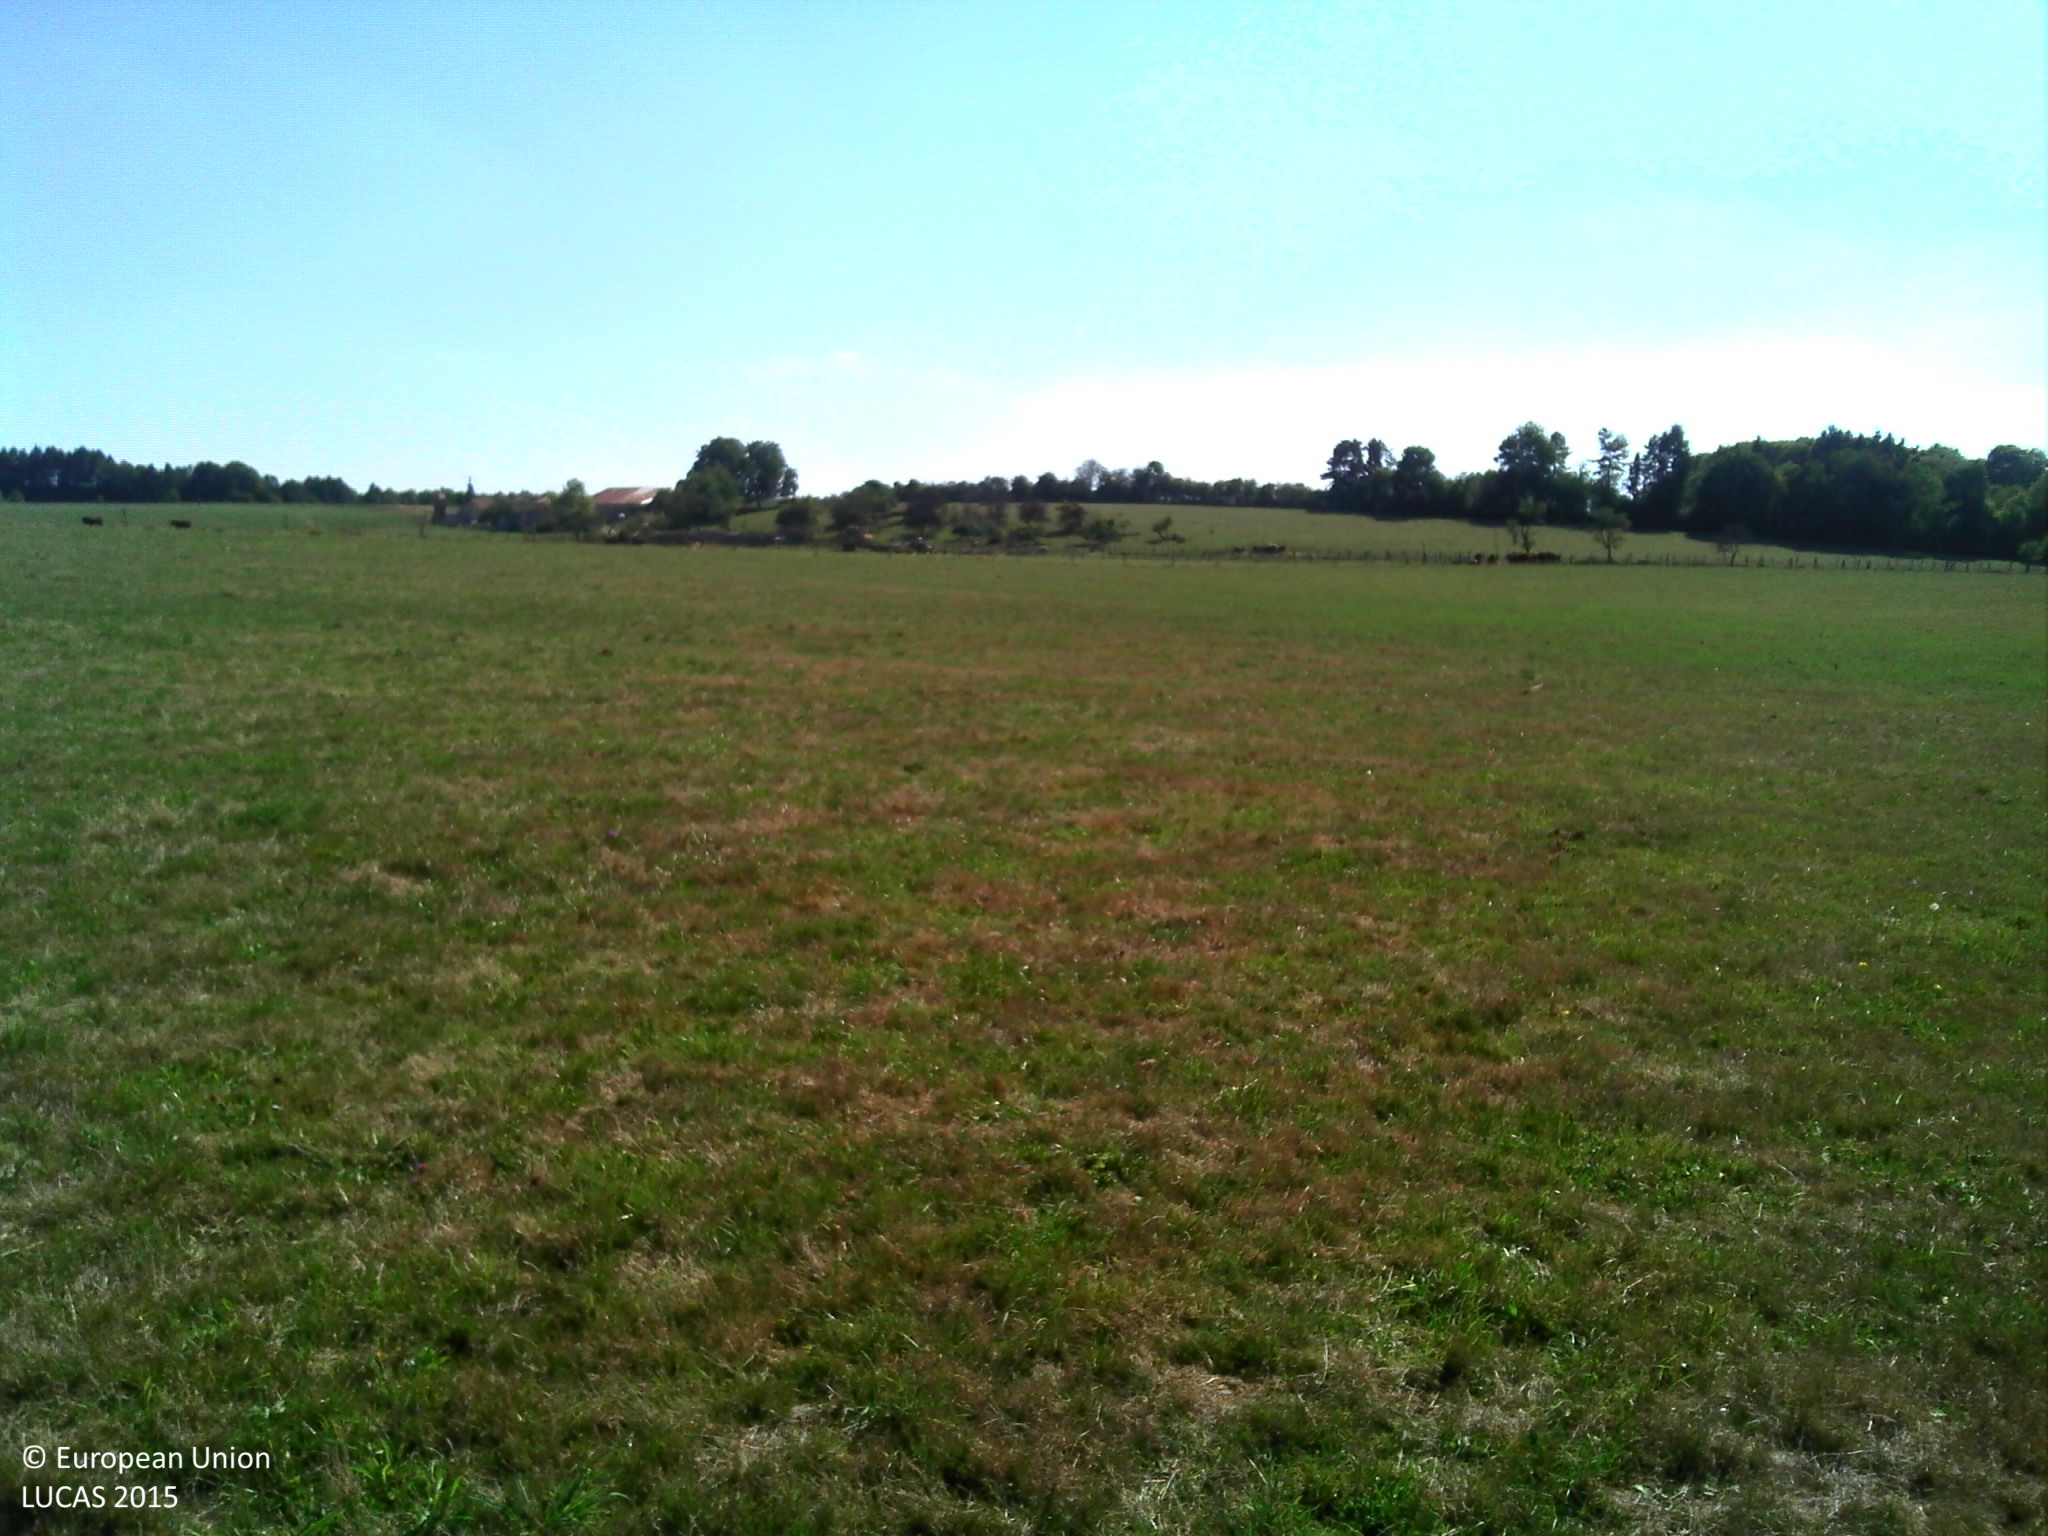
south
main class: Grassland
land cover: Grassland without tree/shrub cover
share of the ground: > 75 %
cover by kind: herbaceous plants 85 %, consolidated bare surface 15 %
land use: Agriculture (excluding fallow land and kitchen gardens)
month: September
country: FR
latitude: 48.6562
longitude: 6.0222
